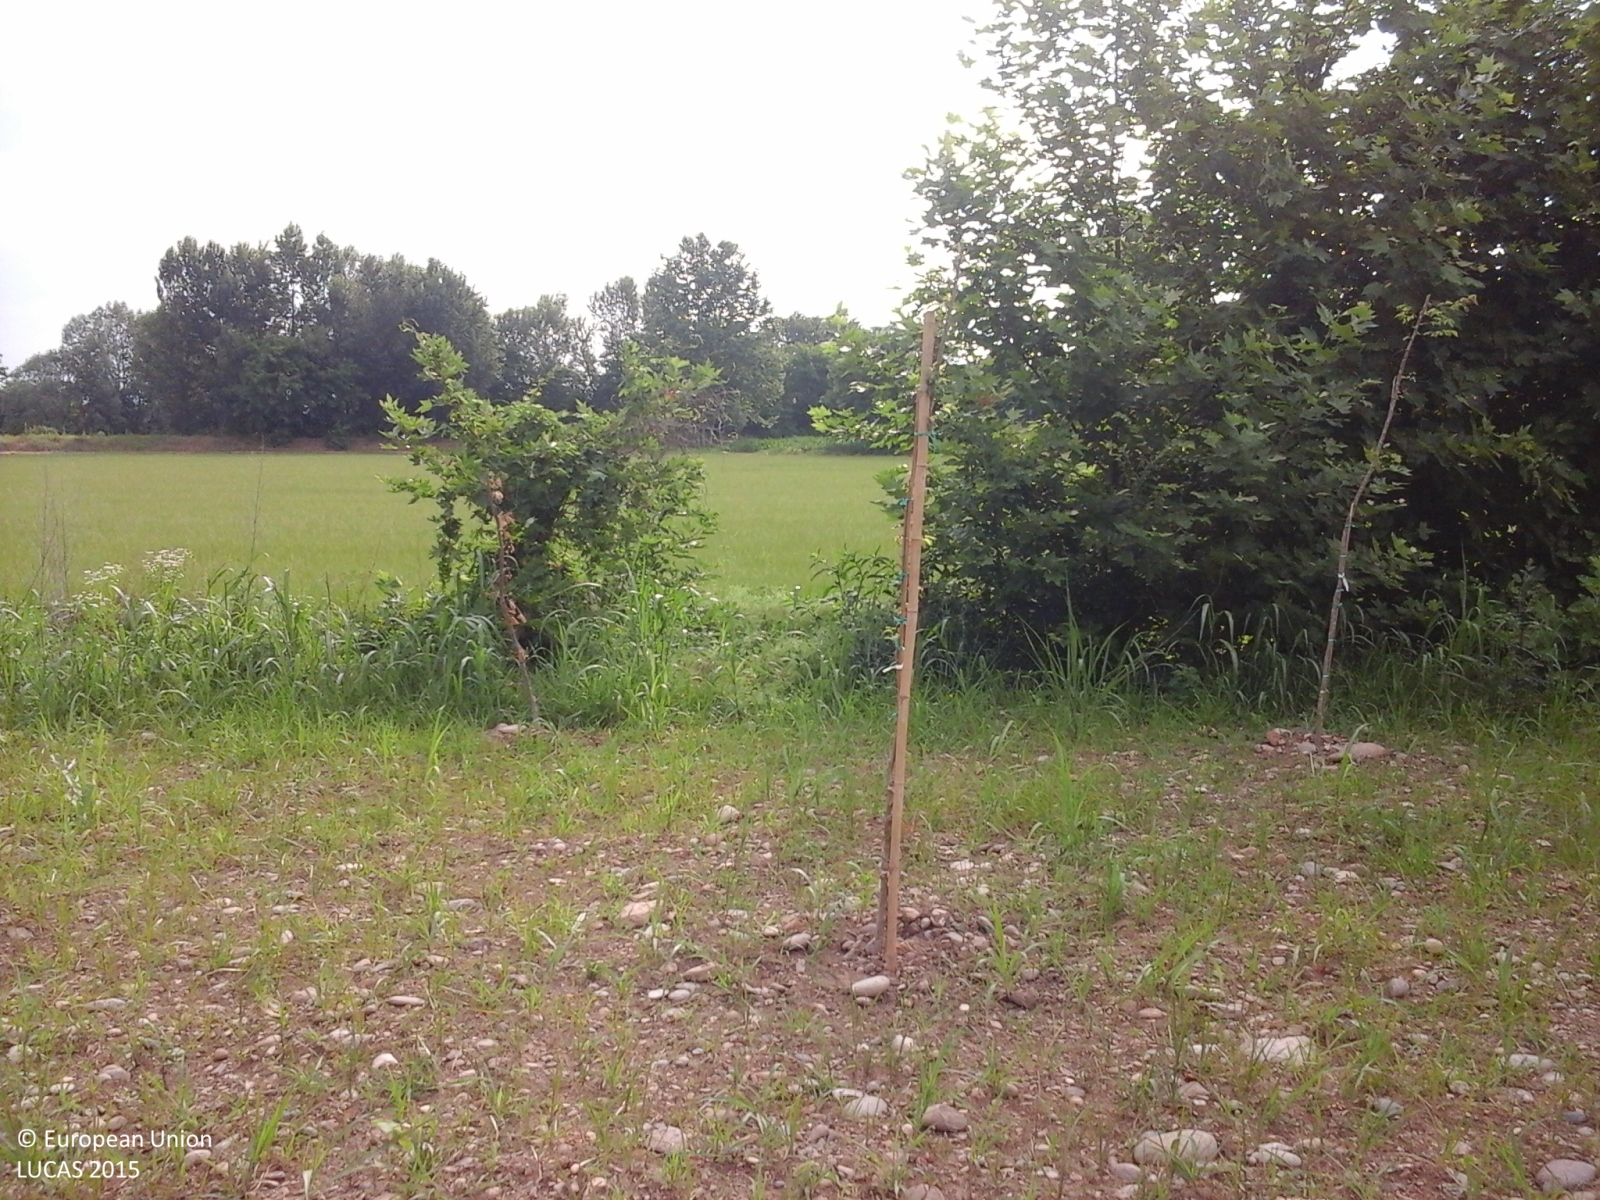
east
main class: Grassland
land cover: Grassland with sparse tree/shrub cover
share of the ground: > 75 %
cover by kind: herbaceous plants 95 %, broadleaved forest trees 5 %
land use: Road transport
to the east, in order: Grassland with sparse tree/shrub cover; Abandoned hedges; Inland fresh running water; Shruby margins; Temporary grasslands; Other structural elements; Grass margins; Tracks; Grassland with sparse tree/shrub cover; Ditches and canals; Tracks; Maize; Grass margins; Ditches and canals; Temporary grasslands; Ditches and canals; Grass margins; Tracks; Broadleaved woodland; Inland fresh running water
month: June
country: IT
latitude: 45.5043
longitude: 9.8595
